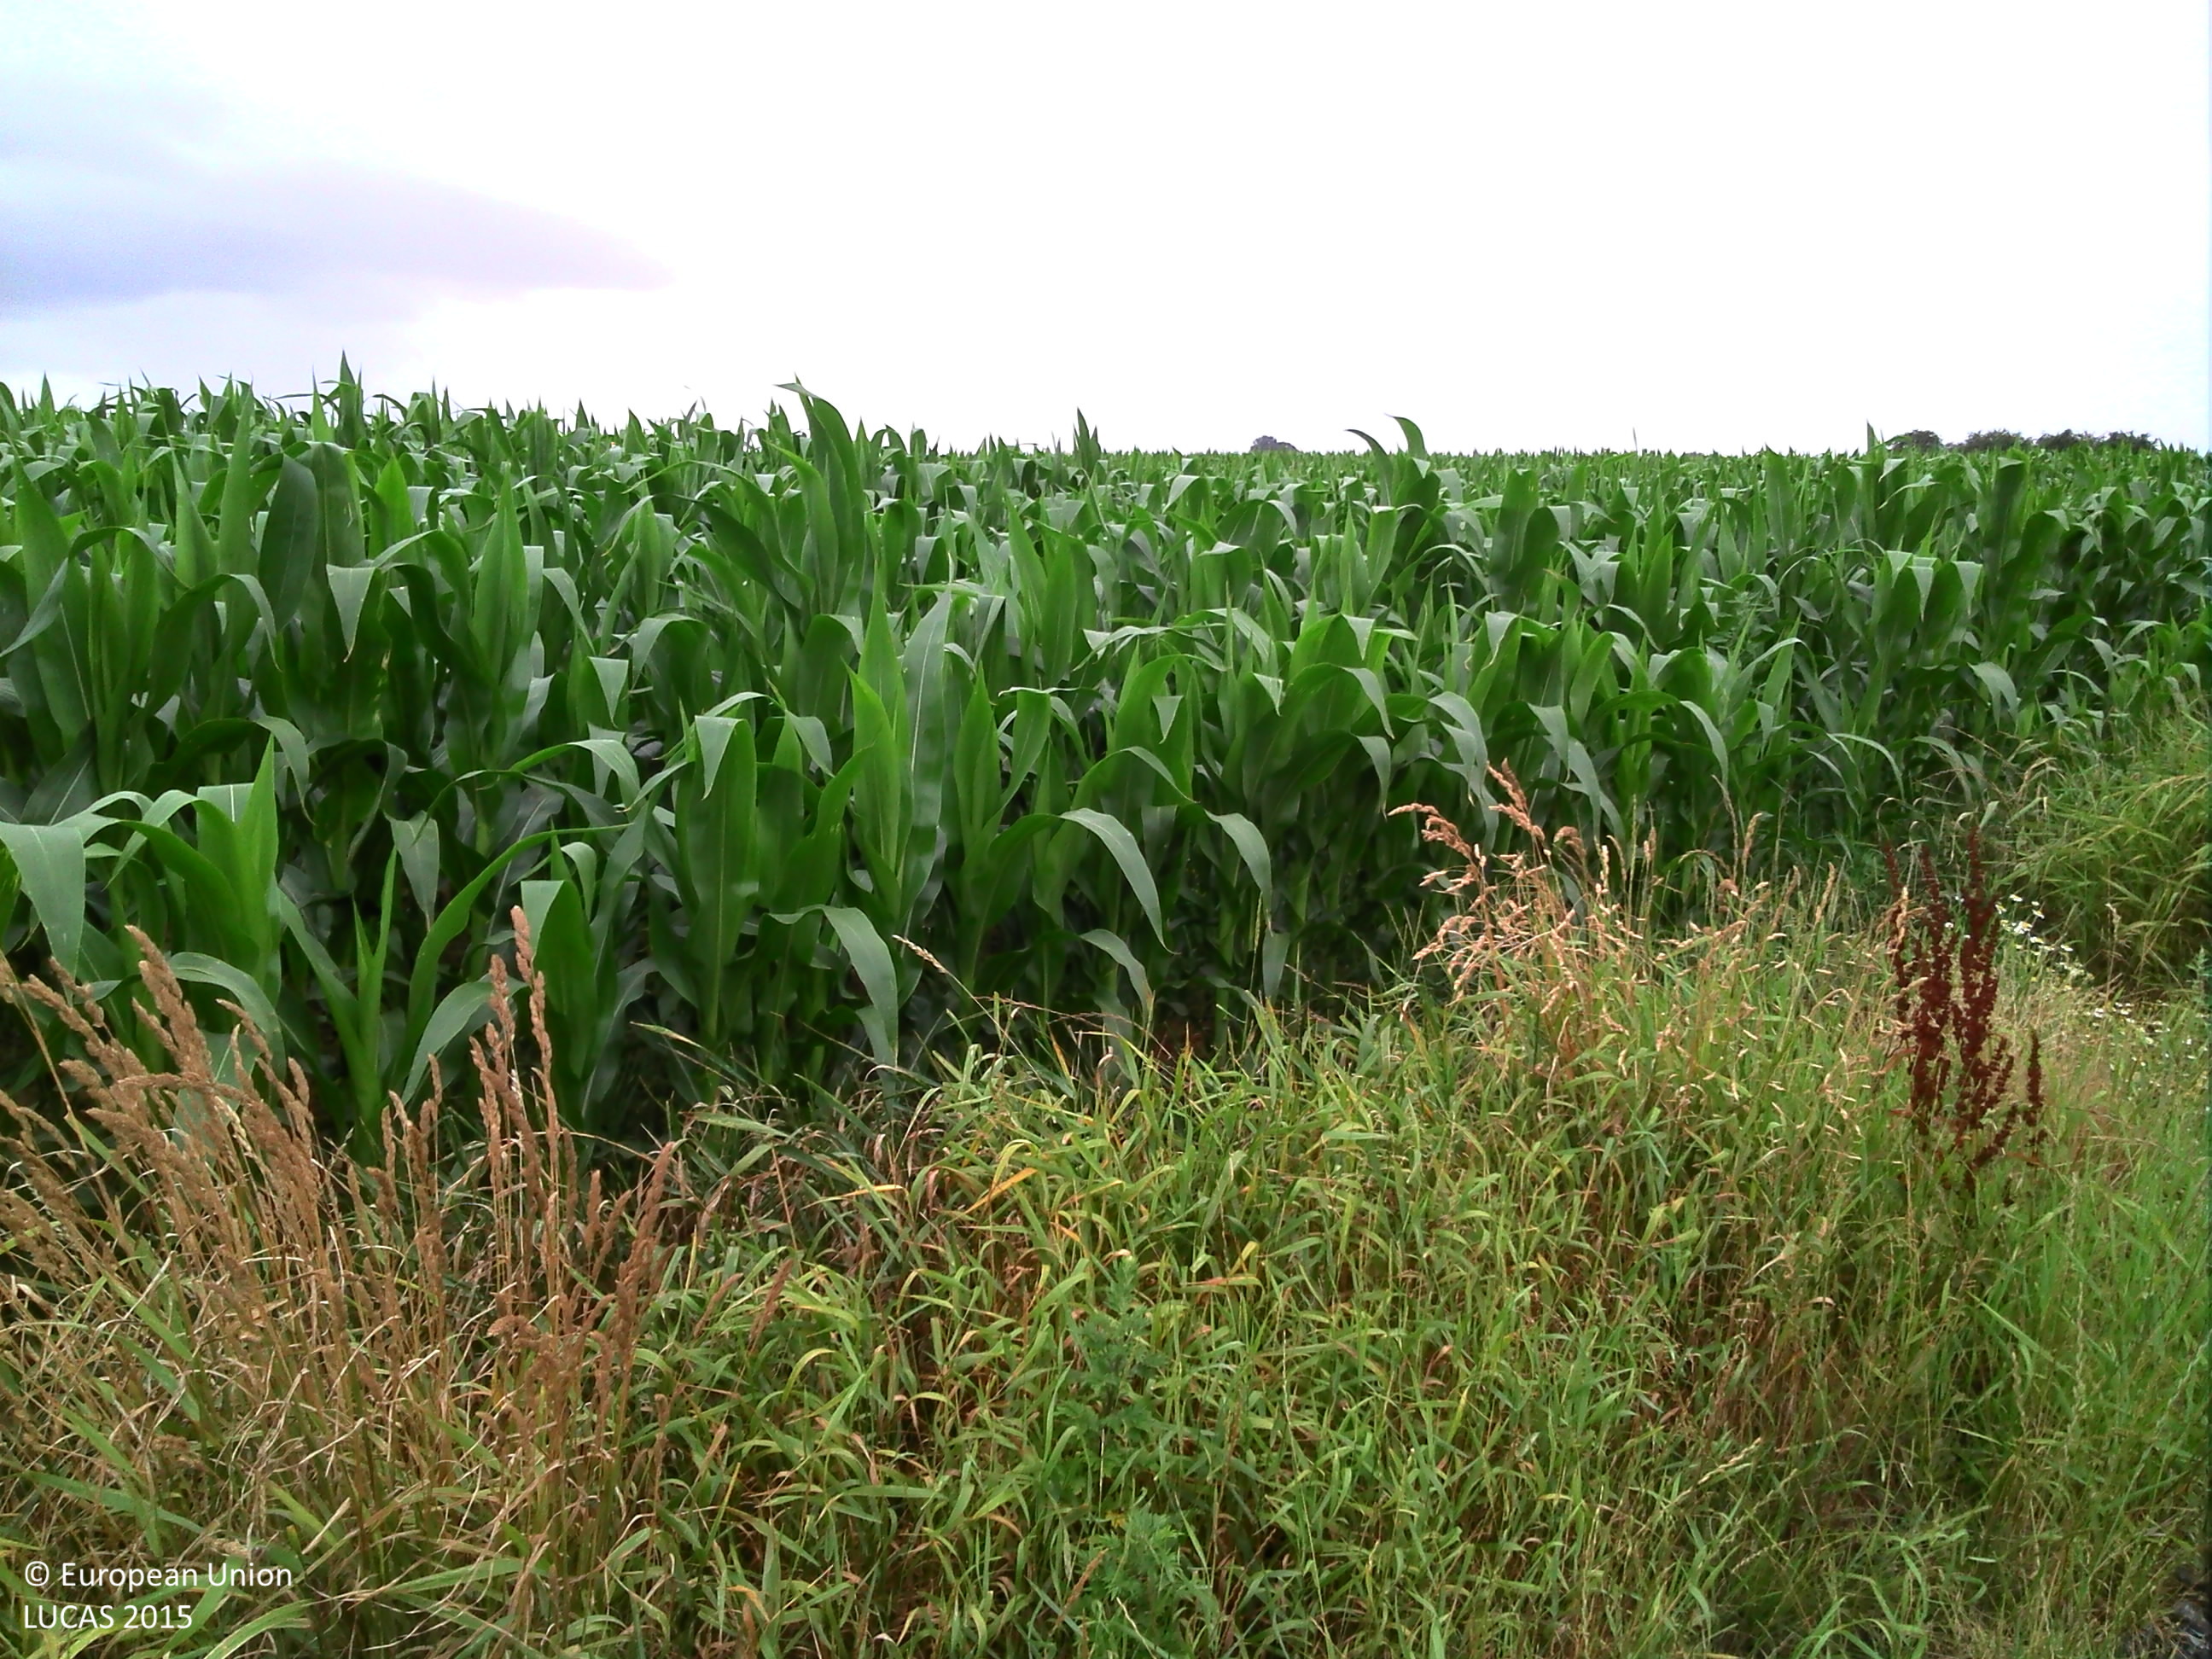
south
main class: Cropland
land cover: Maize
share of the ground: > 75 %
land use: Agriculture (excluding fallow land and kitchen gardens)
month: July
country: BE
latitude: 50.8494
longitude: 5.4387
